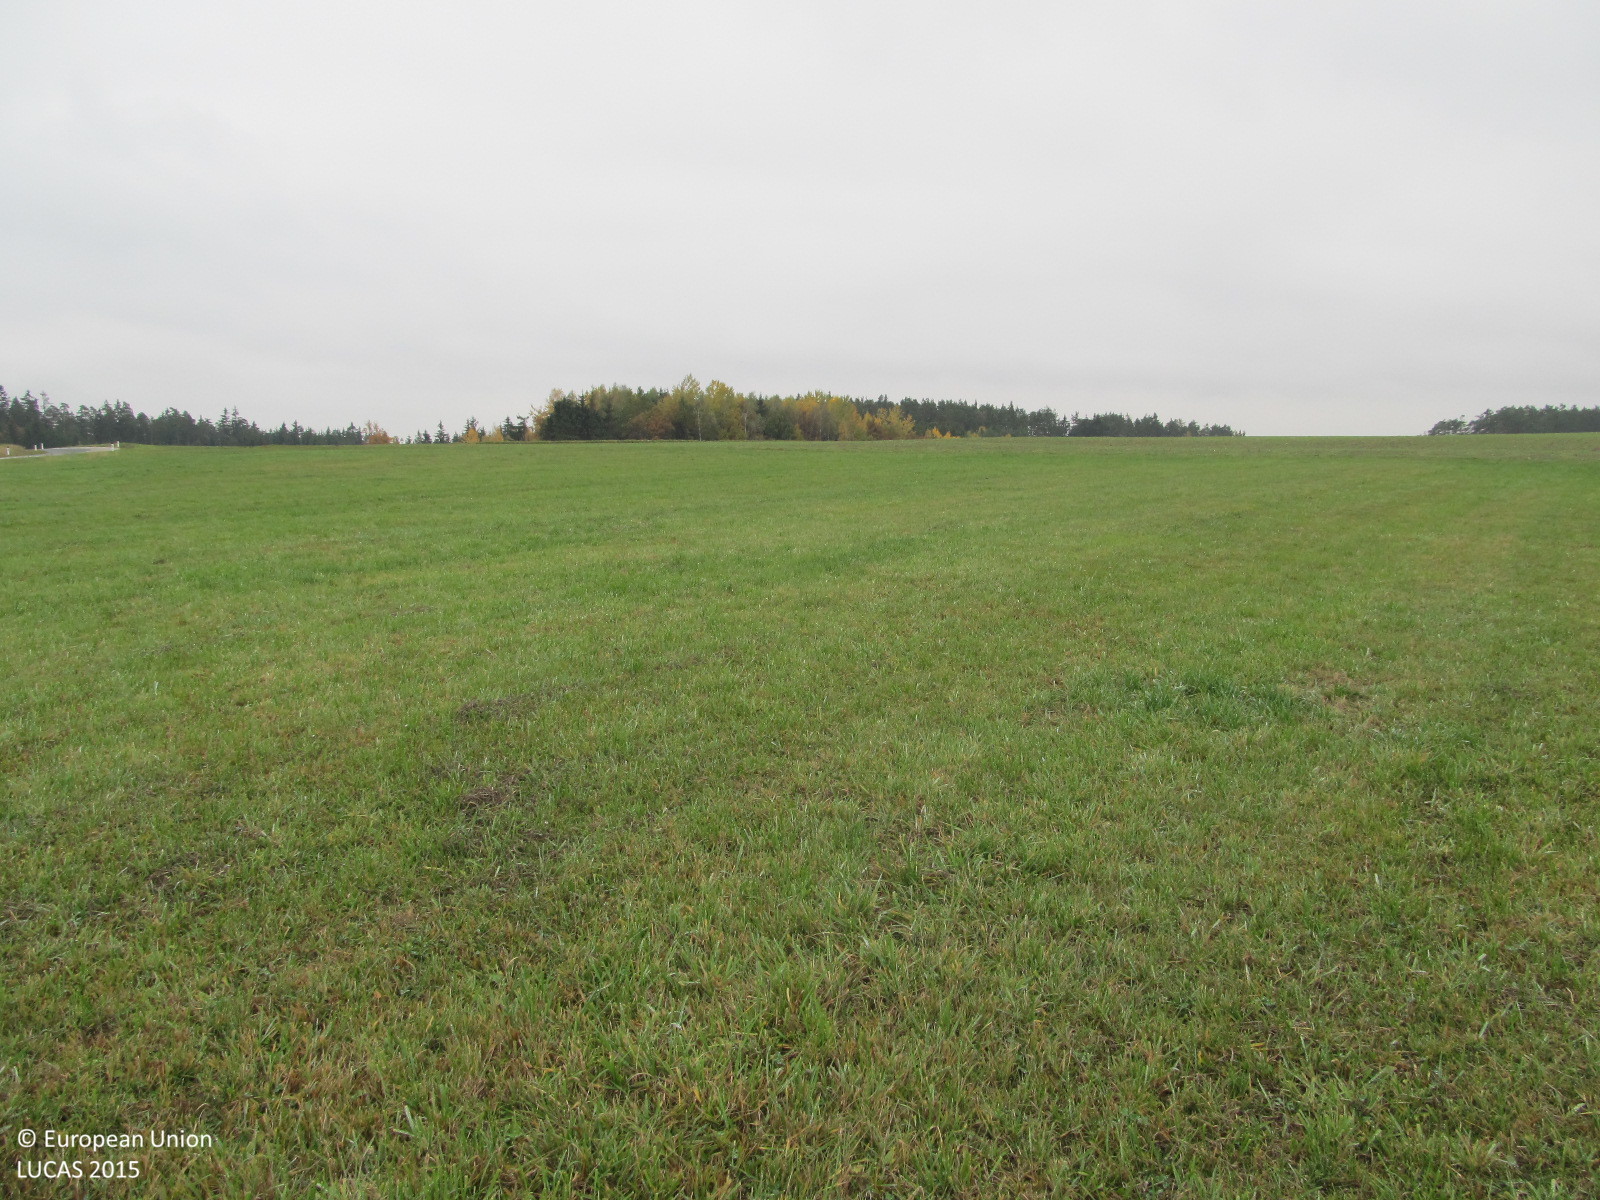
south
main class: Grassland
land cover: Grassland without tree/shrub cover
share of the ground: > 75 %
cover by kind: herbaceous plants 100 %
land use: Agriculture (excluding fallow land and kitchen gardens)
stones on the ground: < 10 %
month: October
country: AT
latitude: 48.6135
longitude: 15.4147
